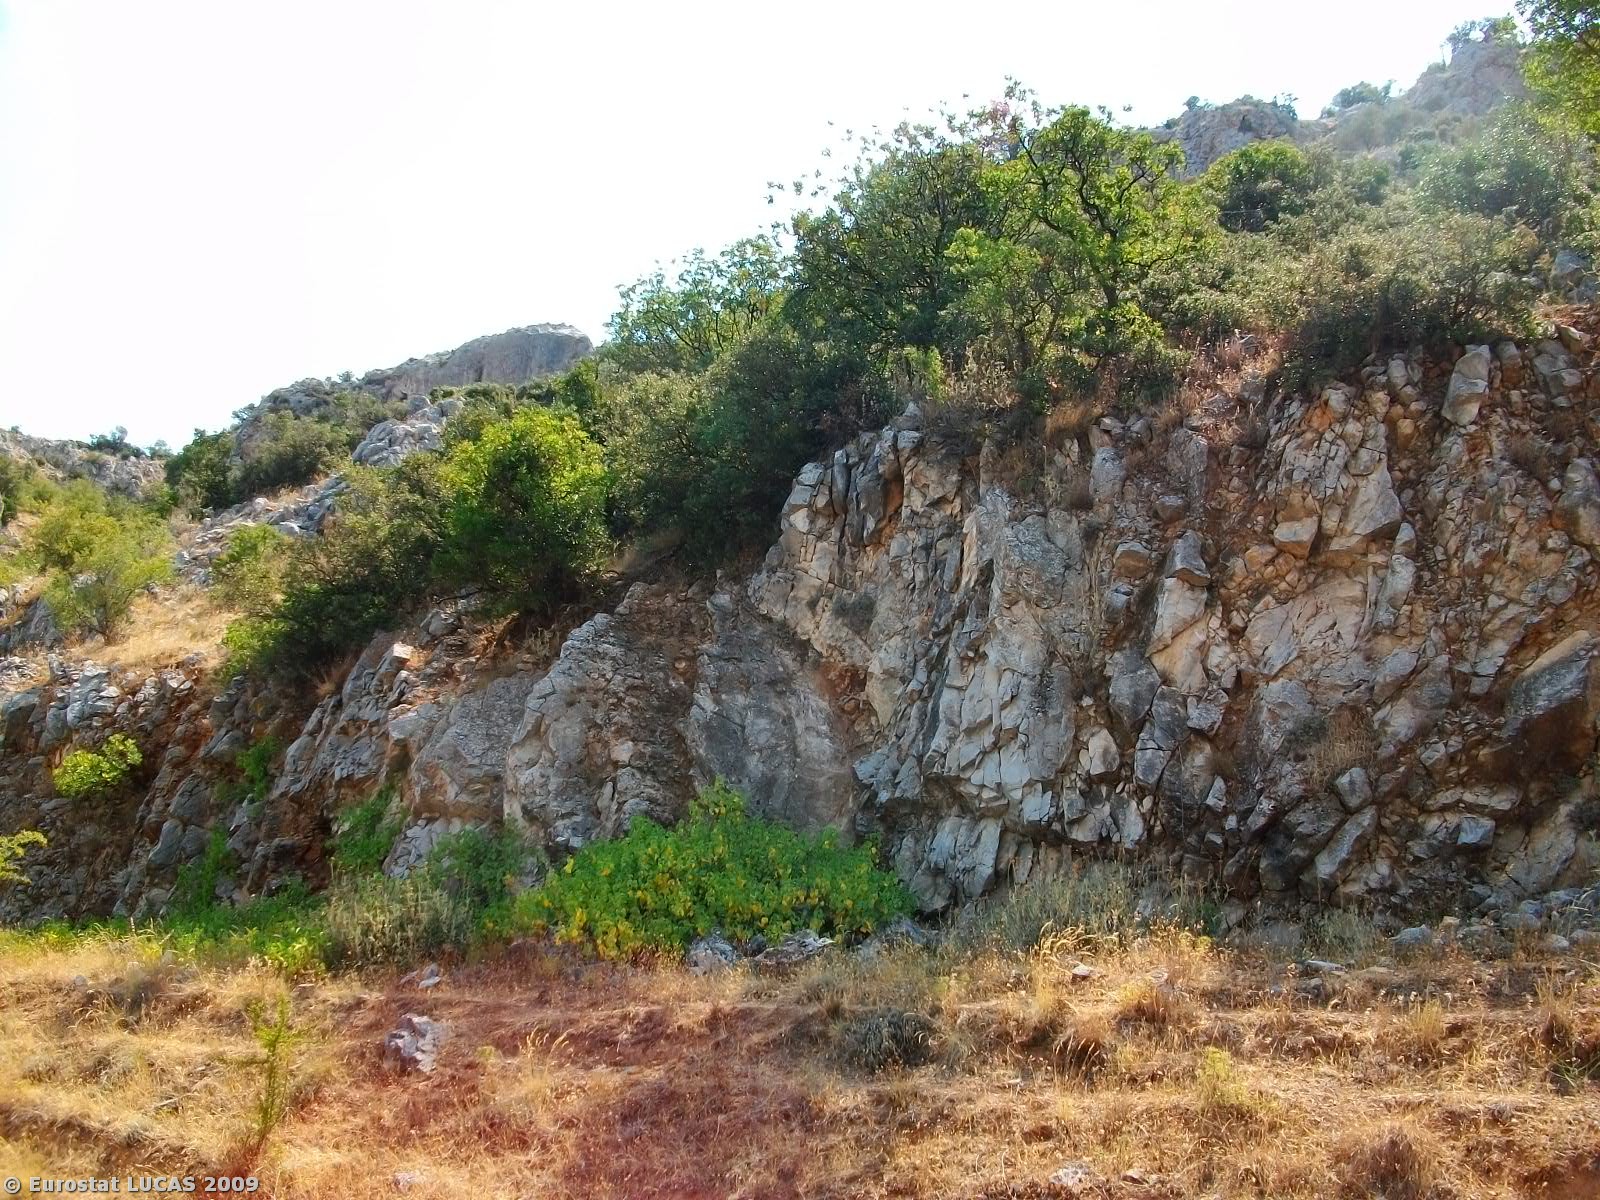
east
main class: Shrubland
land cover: Shrubland without tree cover
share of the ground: > 75 %
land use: Unused
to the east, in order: Shrubland without tree cover; Grass margins; Paved roads, cycling and walking lanes; Grassland without tree/shrub cover; Bare land; Shrubland without tree cover; Bare land; Shrubland without tree cover
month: August
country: GR
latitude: 38.2692
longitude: 23.4808
